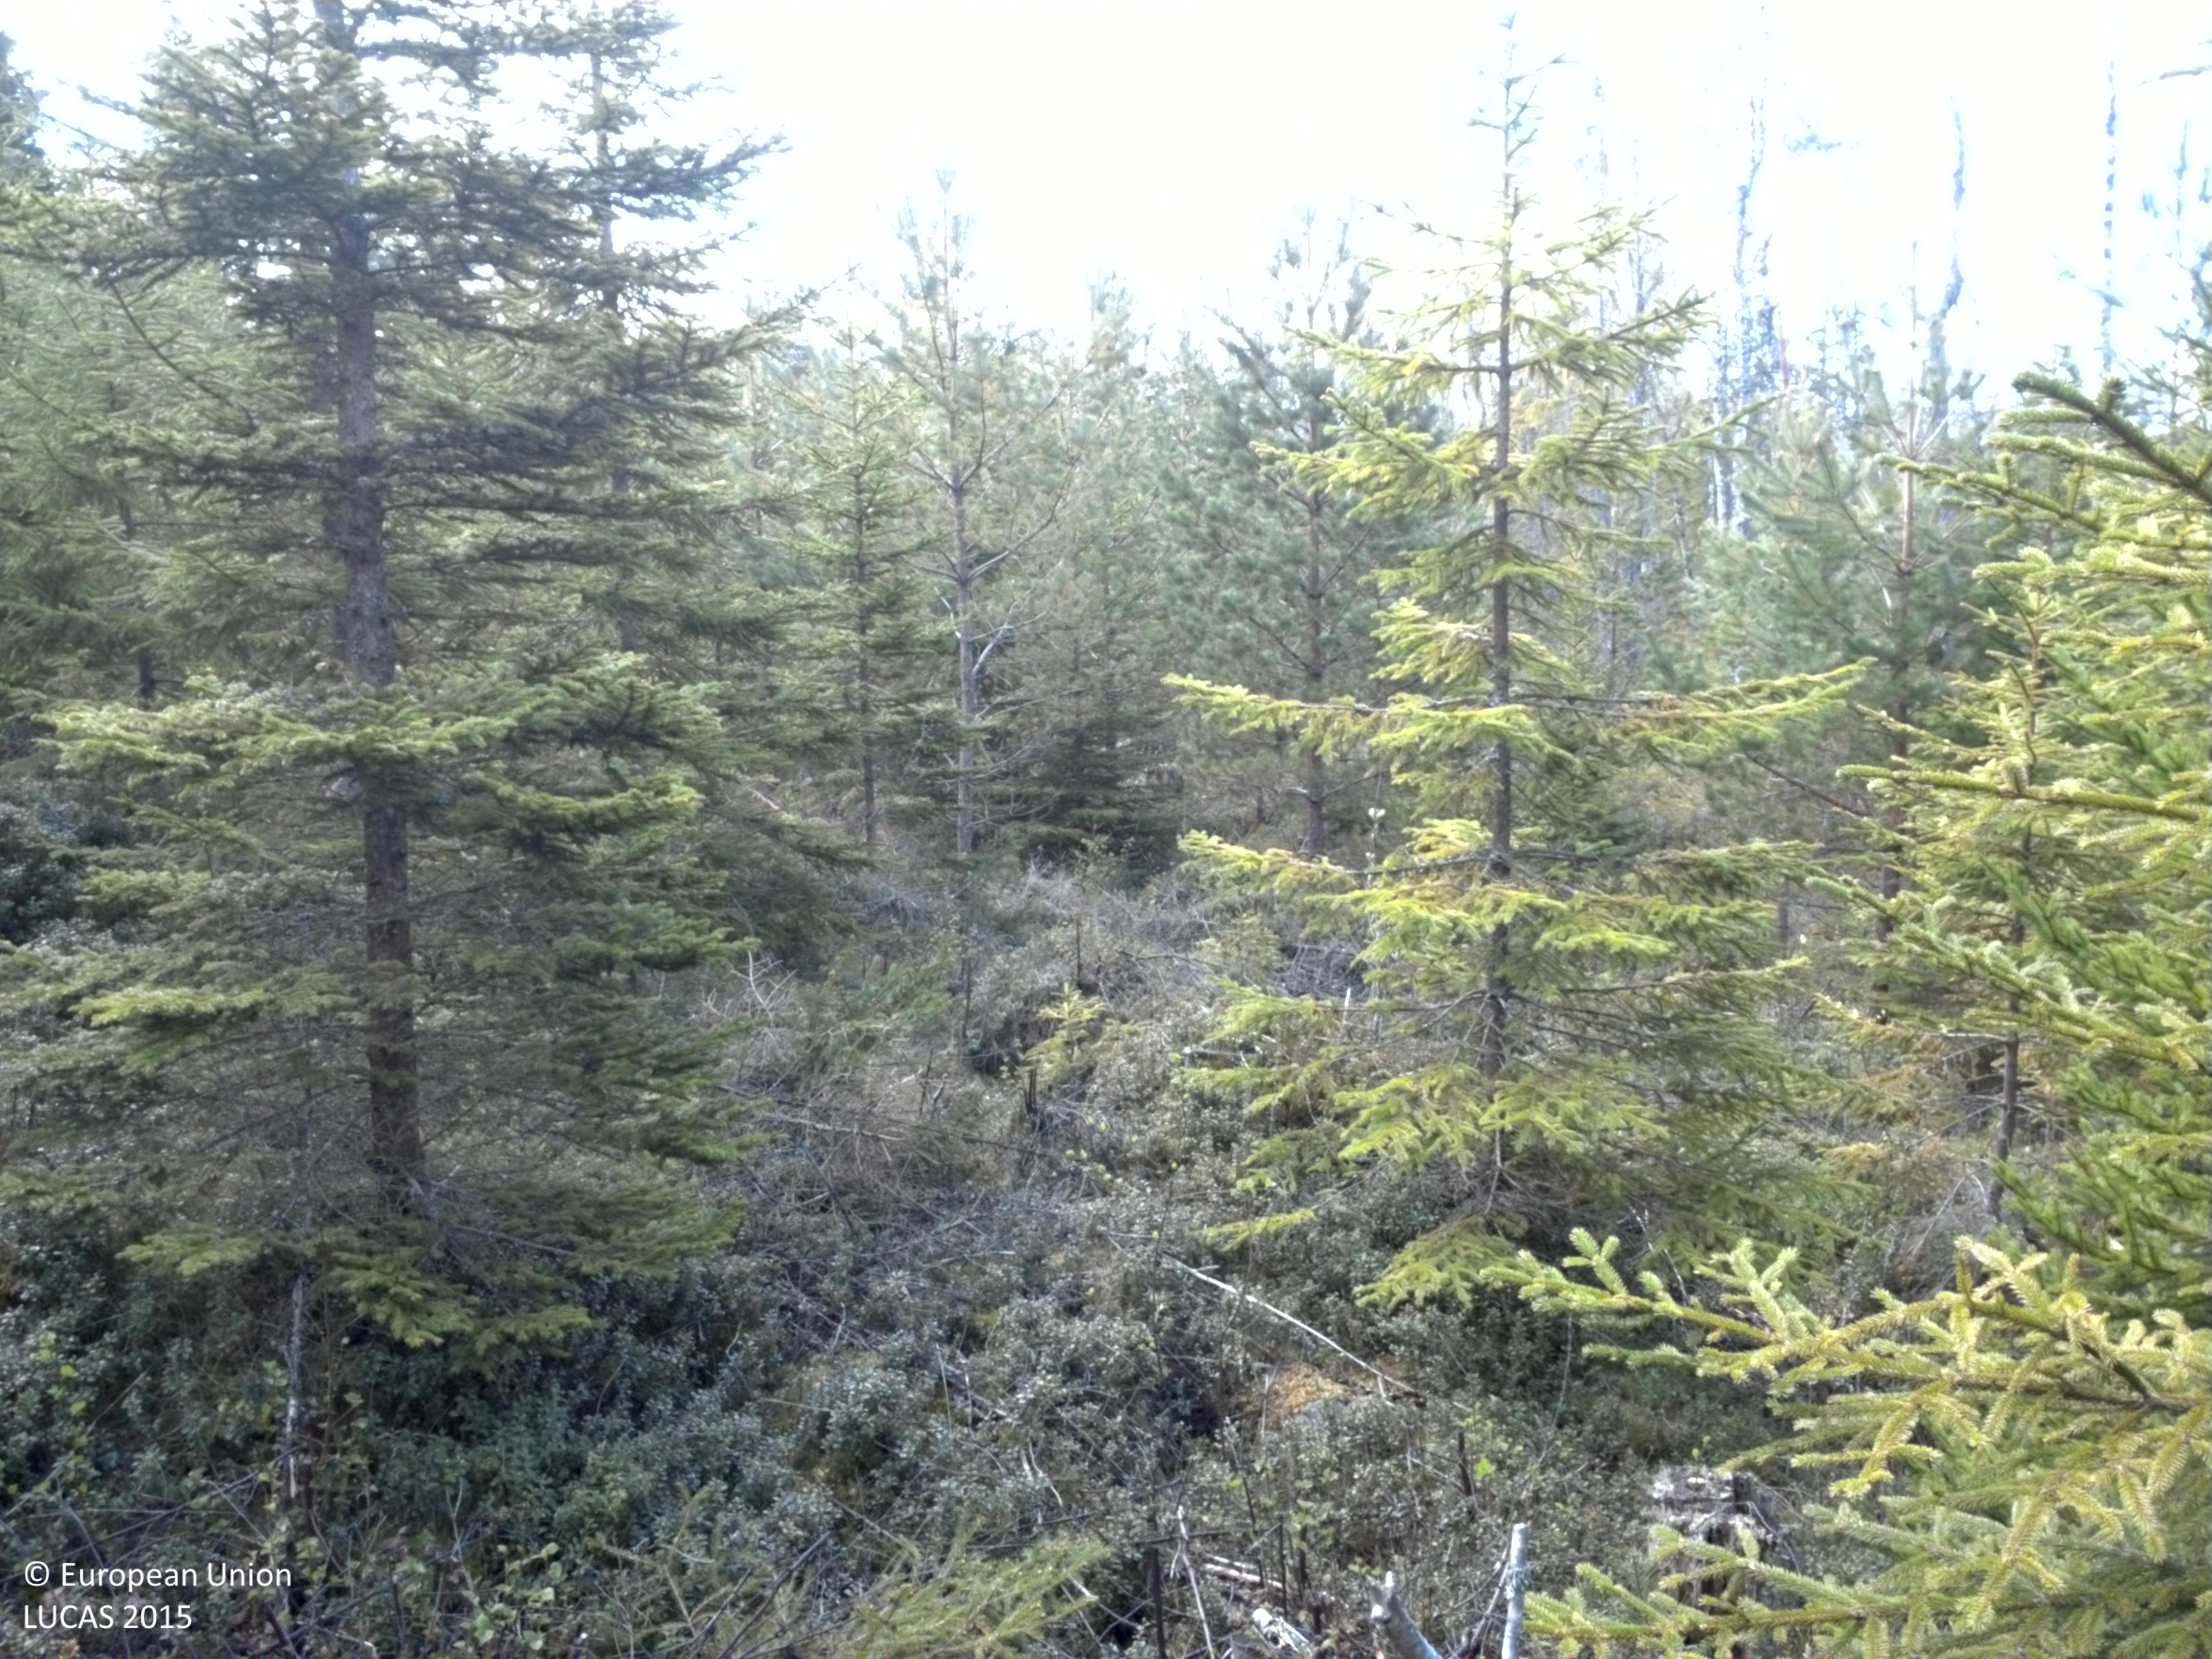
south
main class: Woodland
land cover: Other coniferous woodland
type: boreal forest
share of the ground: > 75 %
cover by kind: coniferous forest trees 75 %, shrubs 10 %, lichens and mosses 10 %, consolidated bare surface 5 %
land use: Forestry
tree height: > 5 m
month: May
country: SE
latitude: 59.2301
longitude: 14.3553
